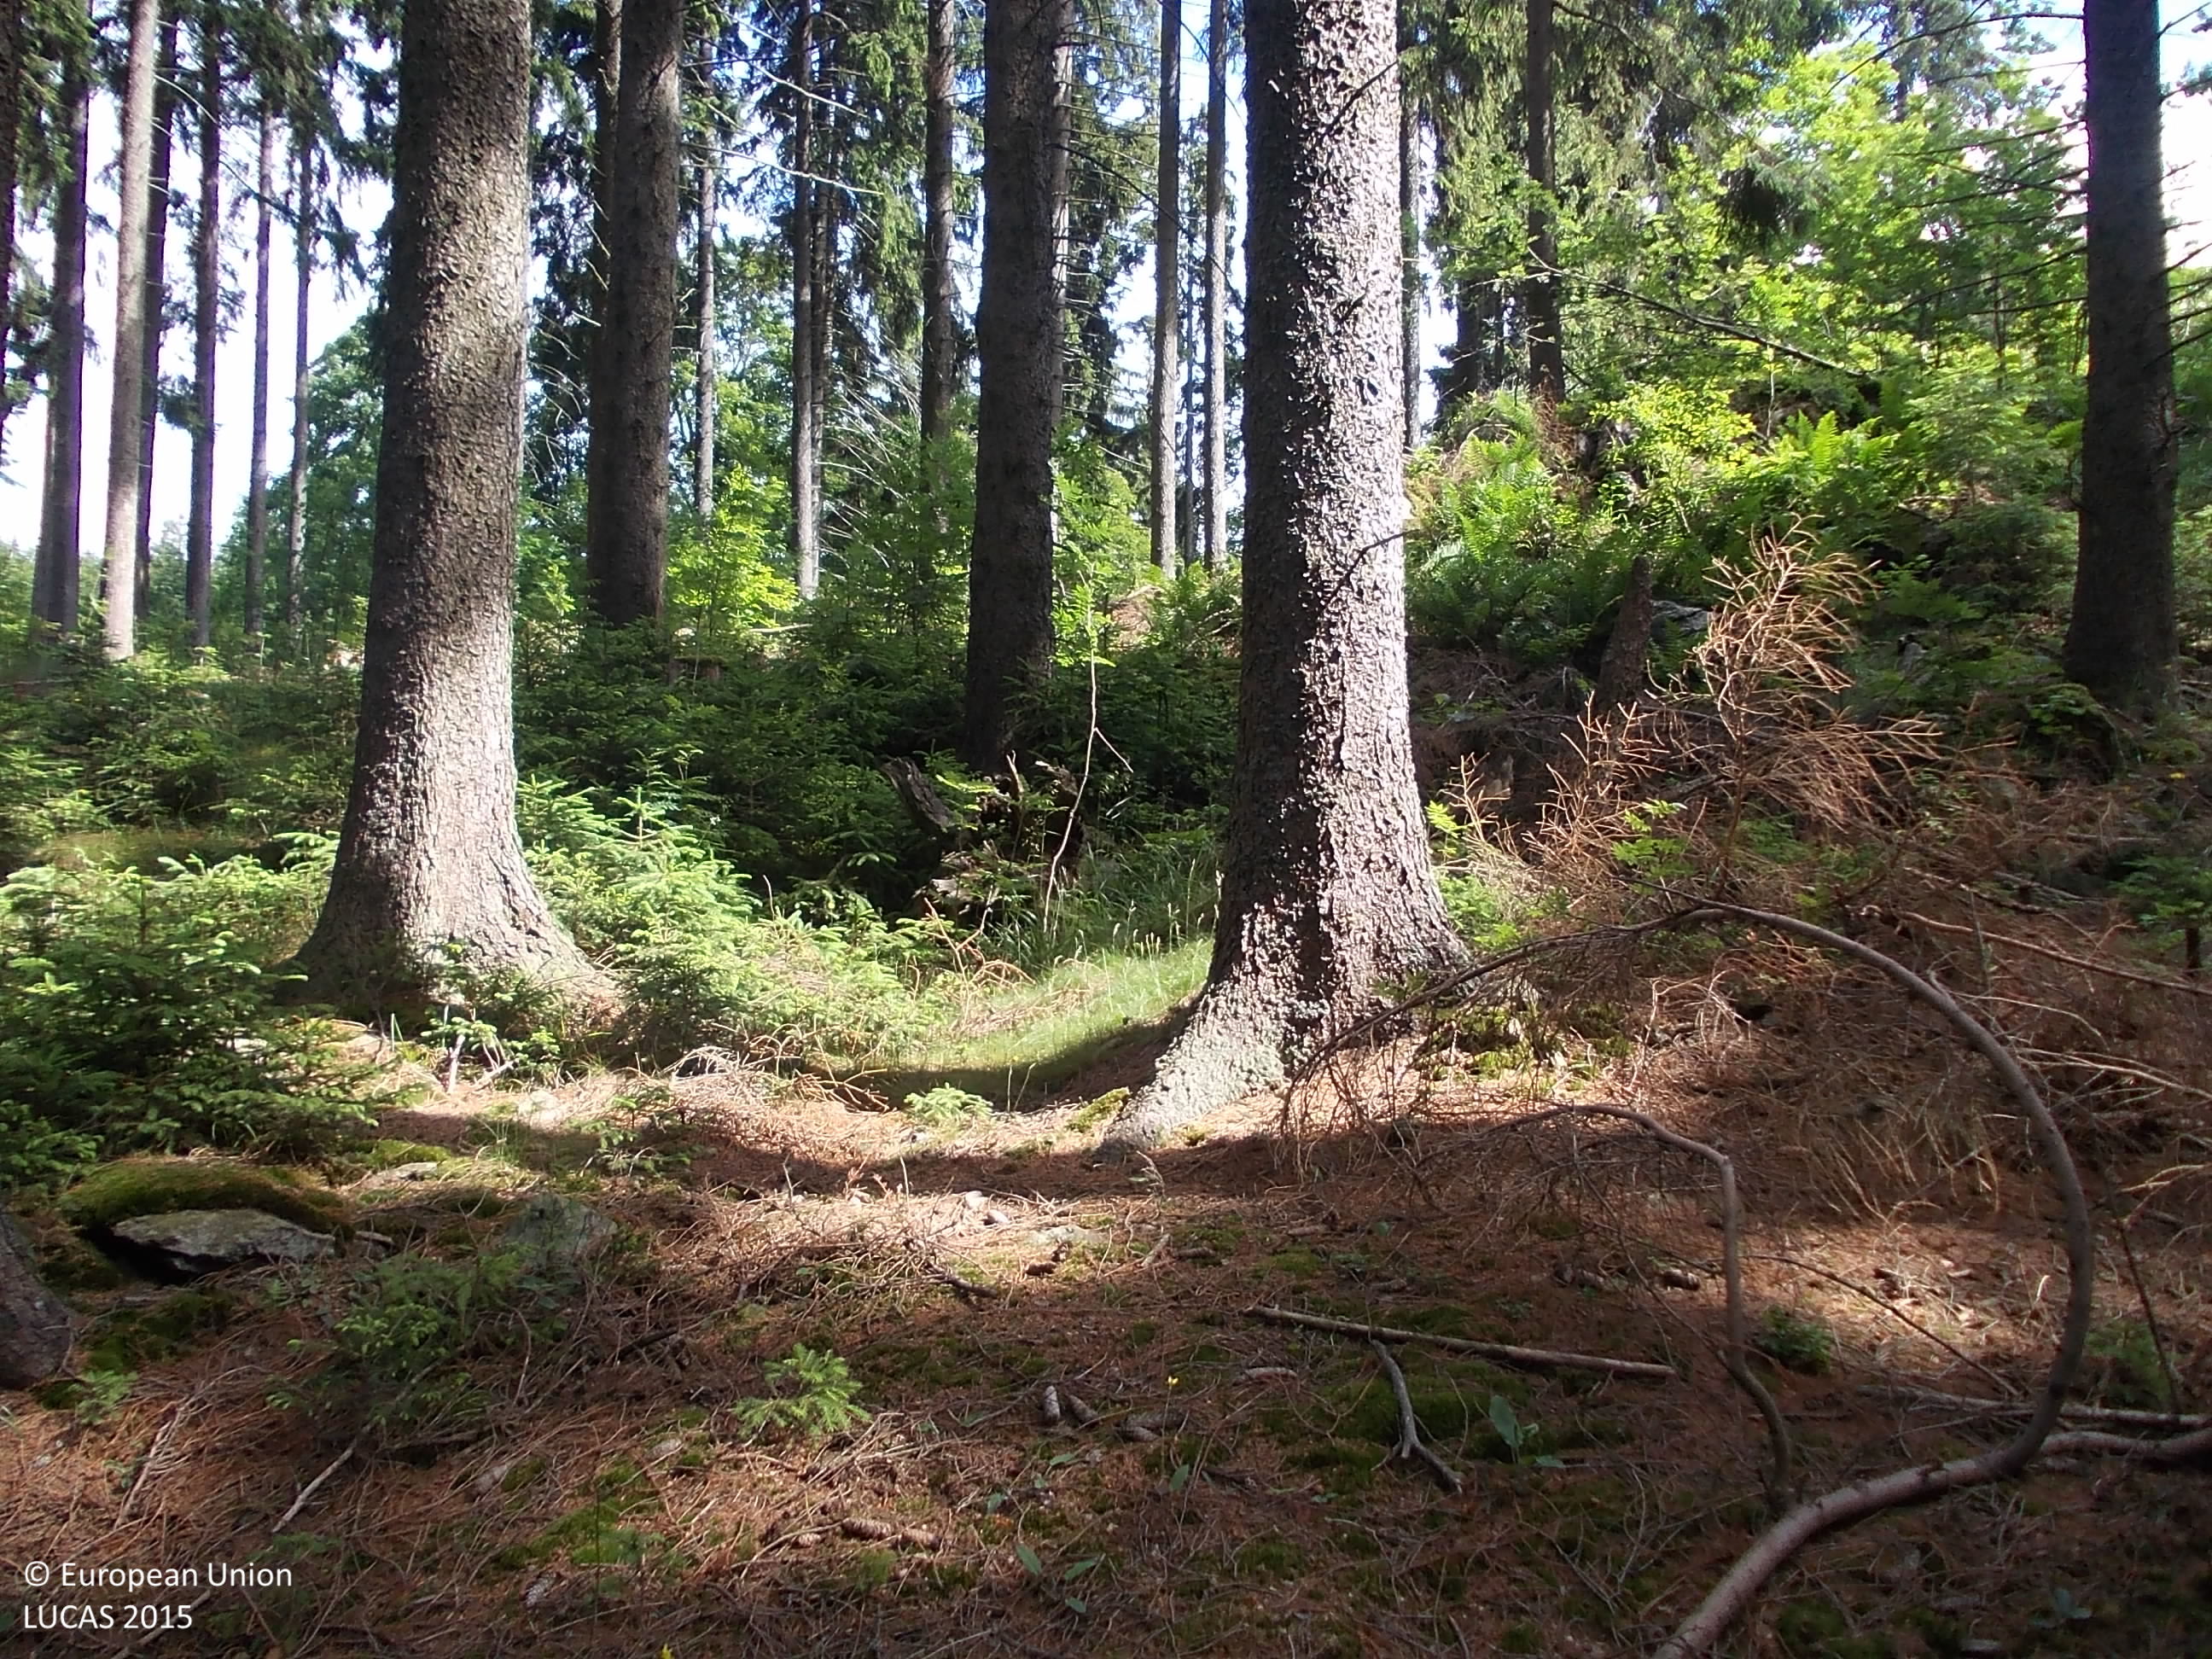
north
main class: Woodland
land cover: Spruce dominated coniferous woodland
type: hemiboreal forest and nemoral coniferous forest and mixed broadleaved-coniferous forest
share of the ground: > 75 %
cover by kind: coniferous forest trees 80 %, consolidated bare surface 10 %, herbaceous plants 5 %, lichens and mosses 5 %
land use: Forestry
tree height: > 5 m
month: June
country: CZ
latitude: 49.0437
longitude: 13.7076
